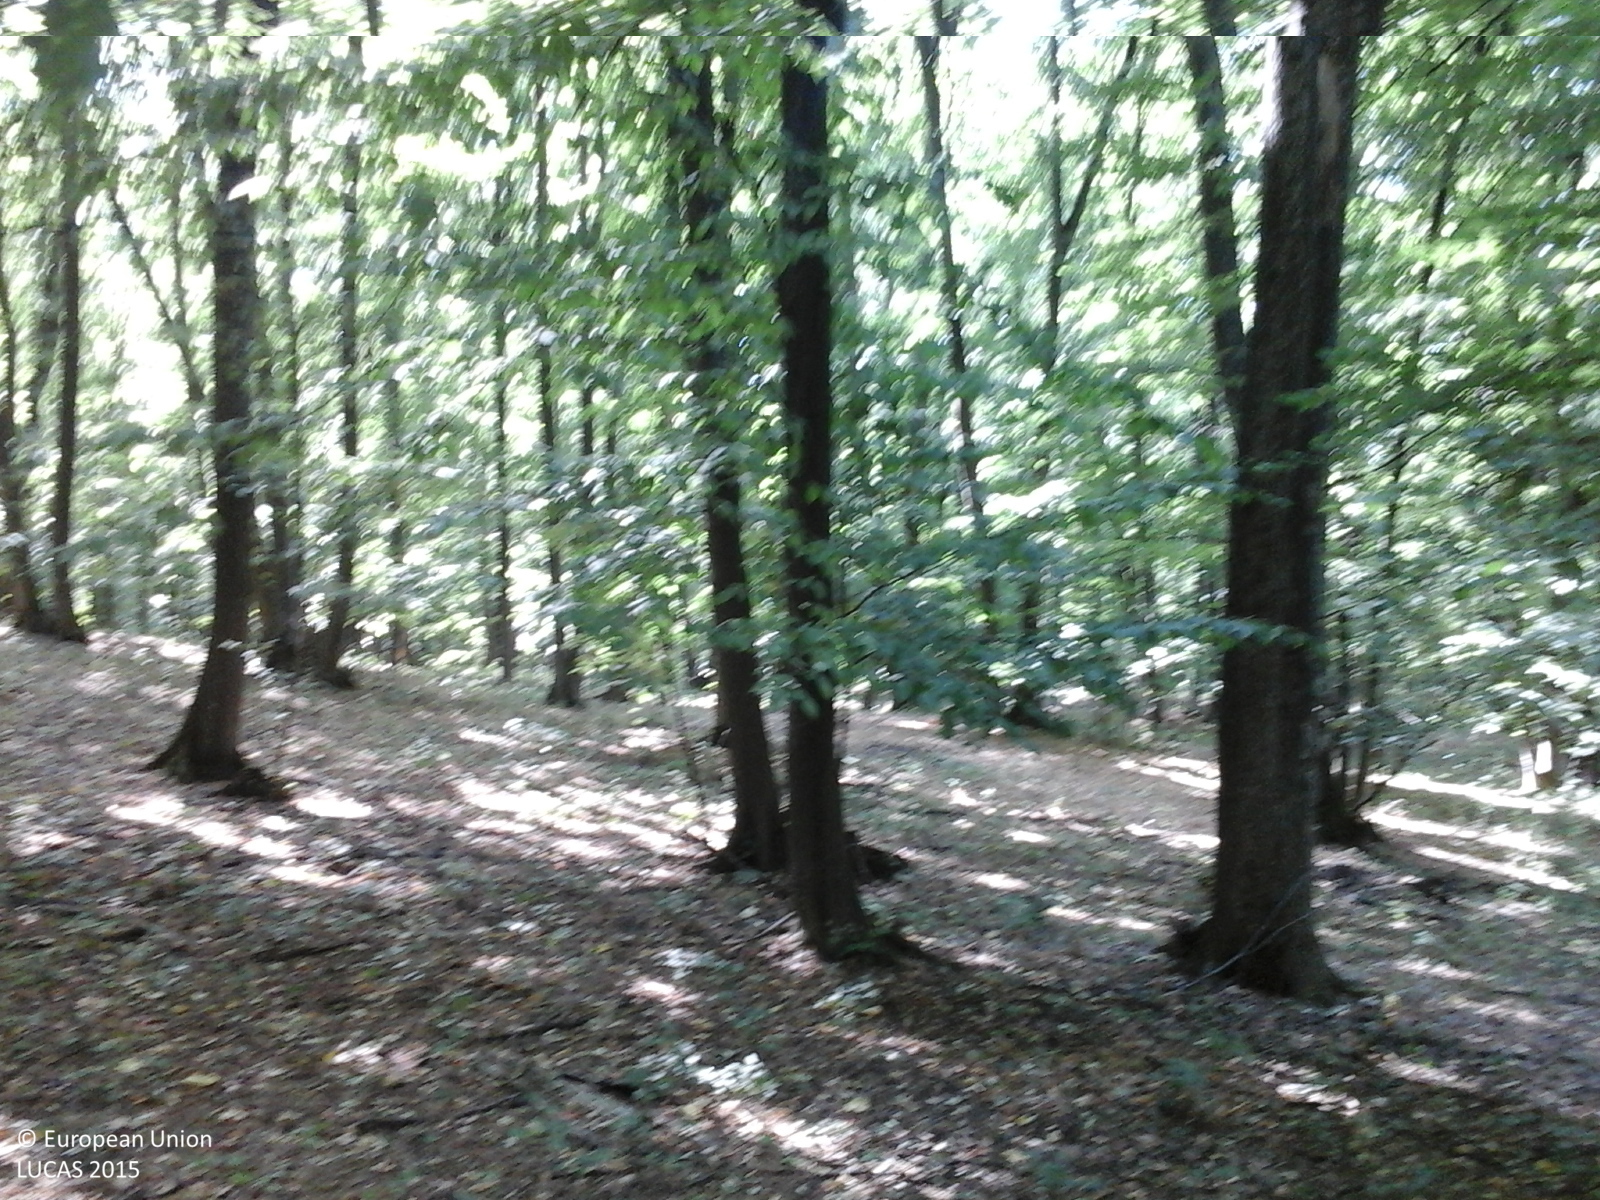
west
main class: Woodland
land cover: Broadleaved woodland
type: beech forest
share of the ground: > 75 %
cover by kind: broadleaved forest trees 100 %
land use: Forestry
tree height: > 5 m
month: June
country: RO
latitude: 46.9968
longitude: 27.9203
